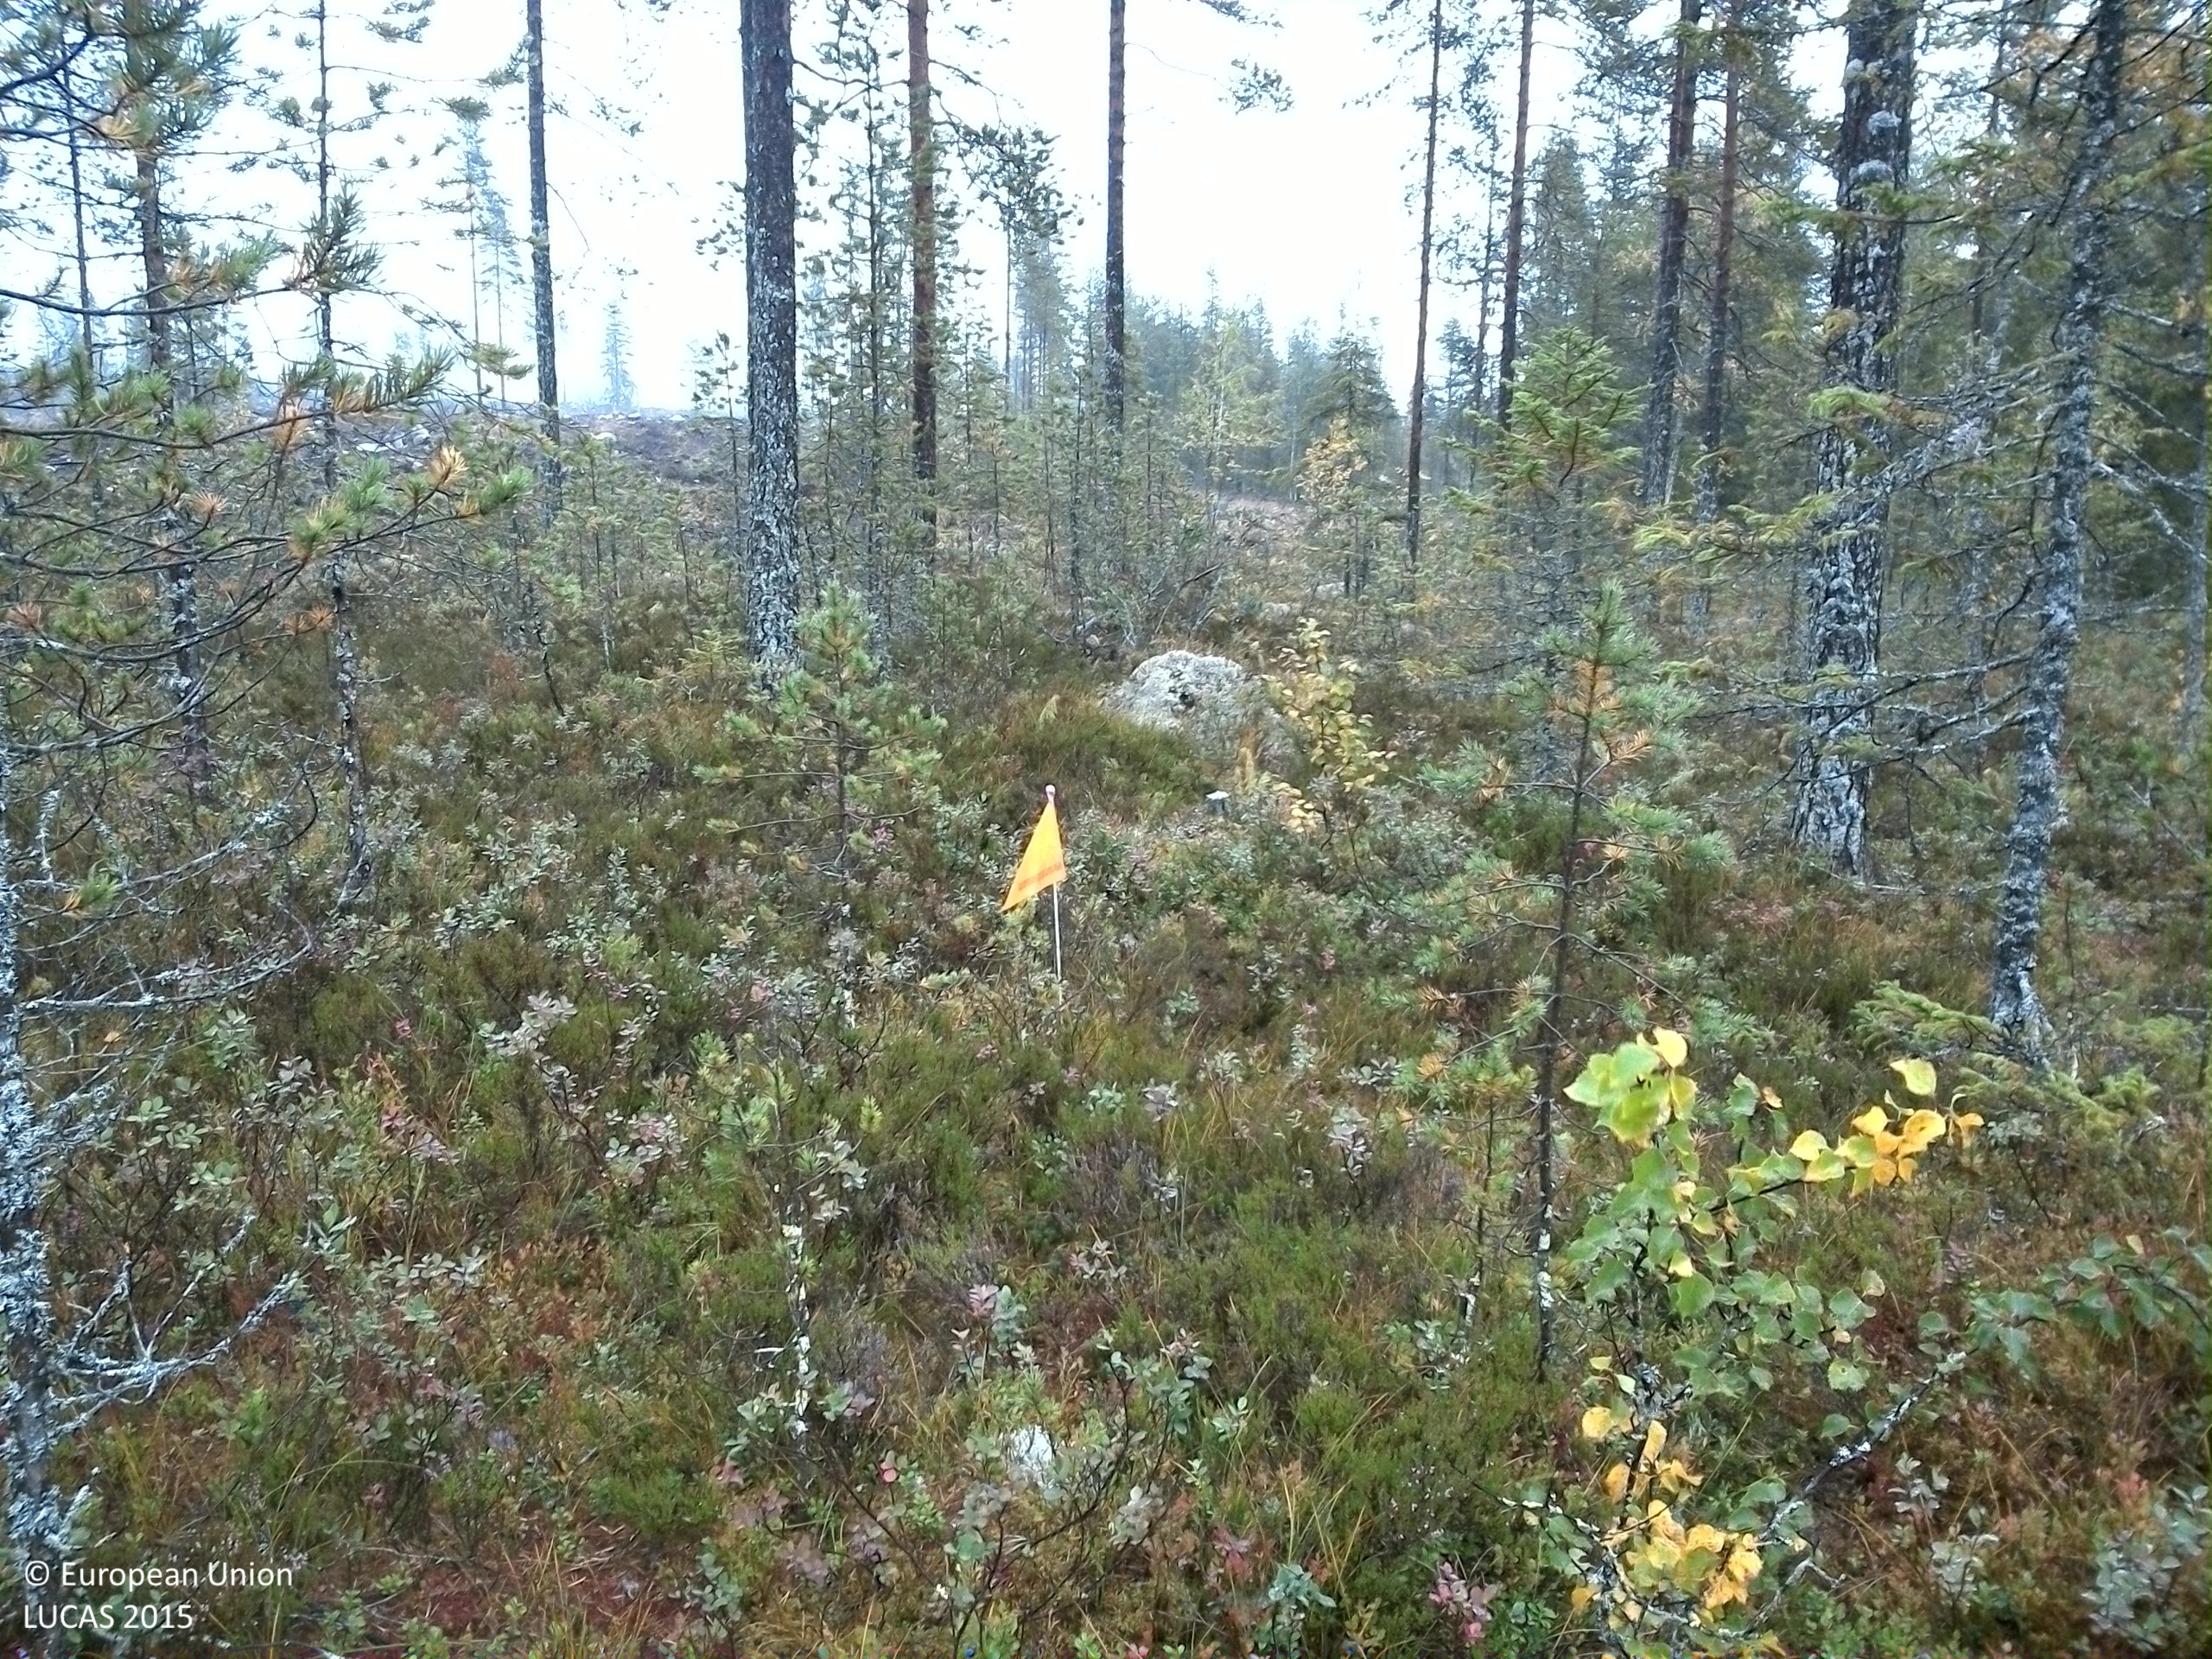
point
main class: Woodland
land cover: Pine dominated coniferous woodland
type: boreal forest
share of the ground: 25 - 50 %
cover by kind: coniferous forest trees 50 %, shrubs 30 %, lichens and mosses 20 %
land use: Forestry
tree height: > 5 m
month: September
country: SE
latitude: 61.4793
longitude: 15.0722
